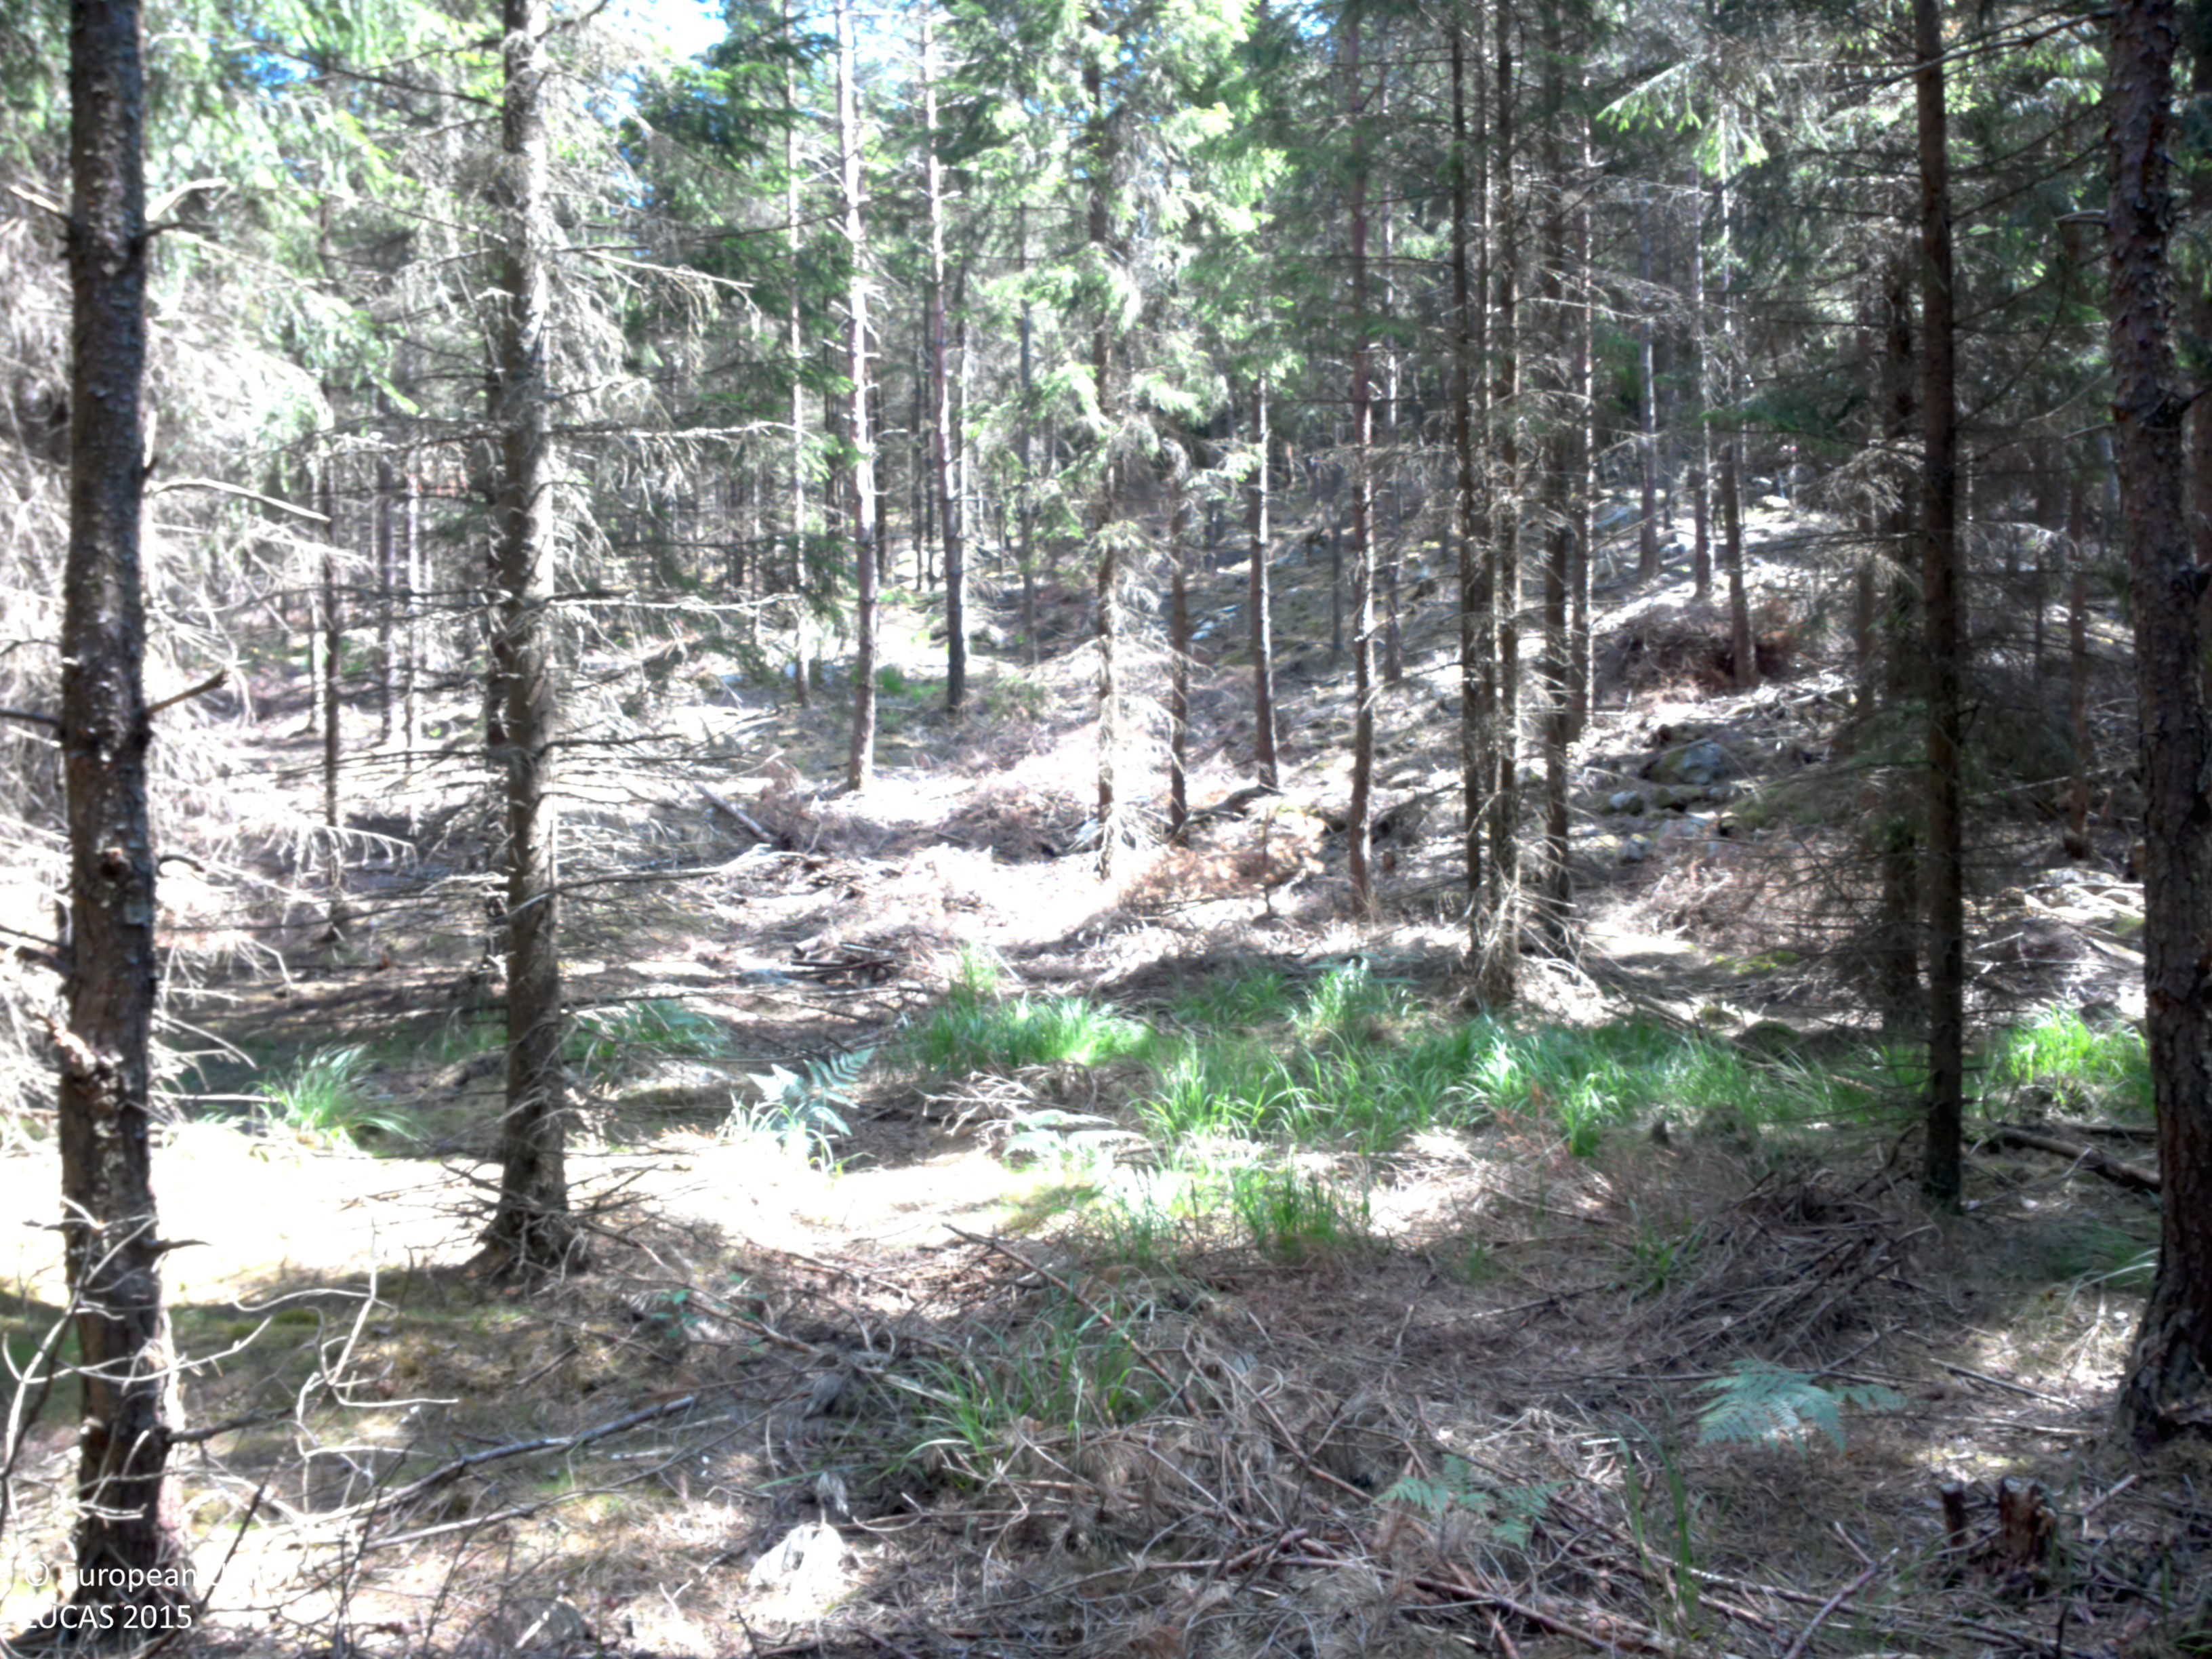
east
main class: Woodland
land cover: Spruce dominated coniferous woodland
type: boreal forest
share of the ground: 50 - 75 %
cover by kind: coniferous forest trees 50 %, herbaceous plants 30 %, lichens and mosses 20 %
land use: Forestry
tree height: > 5 m
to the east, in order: Spruce dominated coniferous woodland; Other coniferous woodland; Other mixed woodland; Pine dominated coniferous woodland; Other coniferous woodland; Other mixed woodland
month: July
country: SE
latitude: 57.9118
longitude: 12.3083
